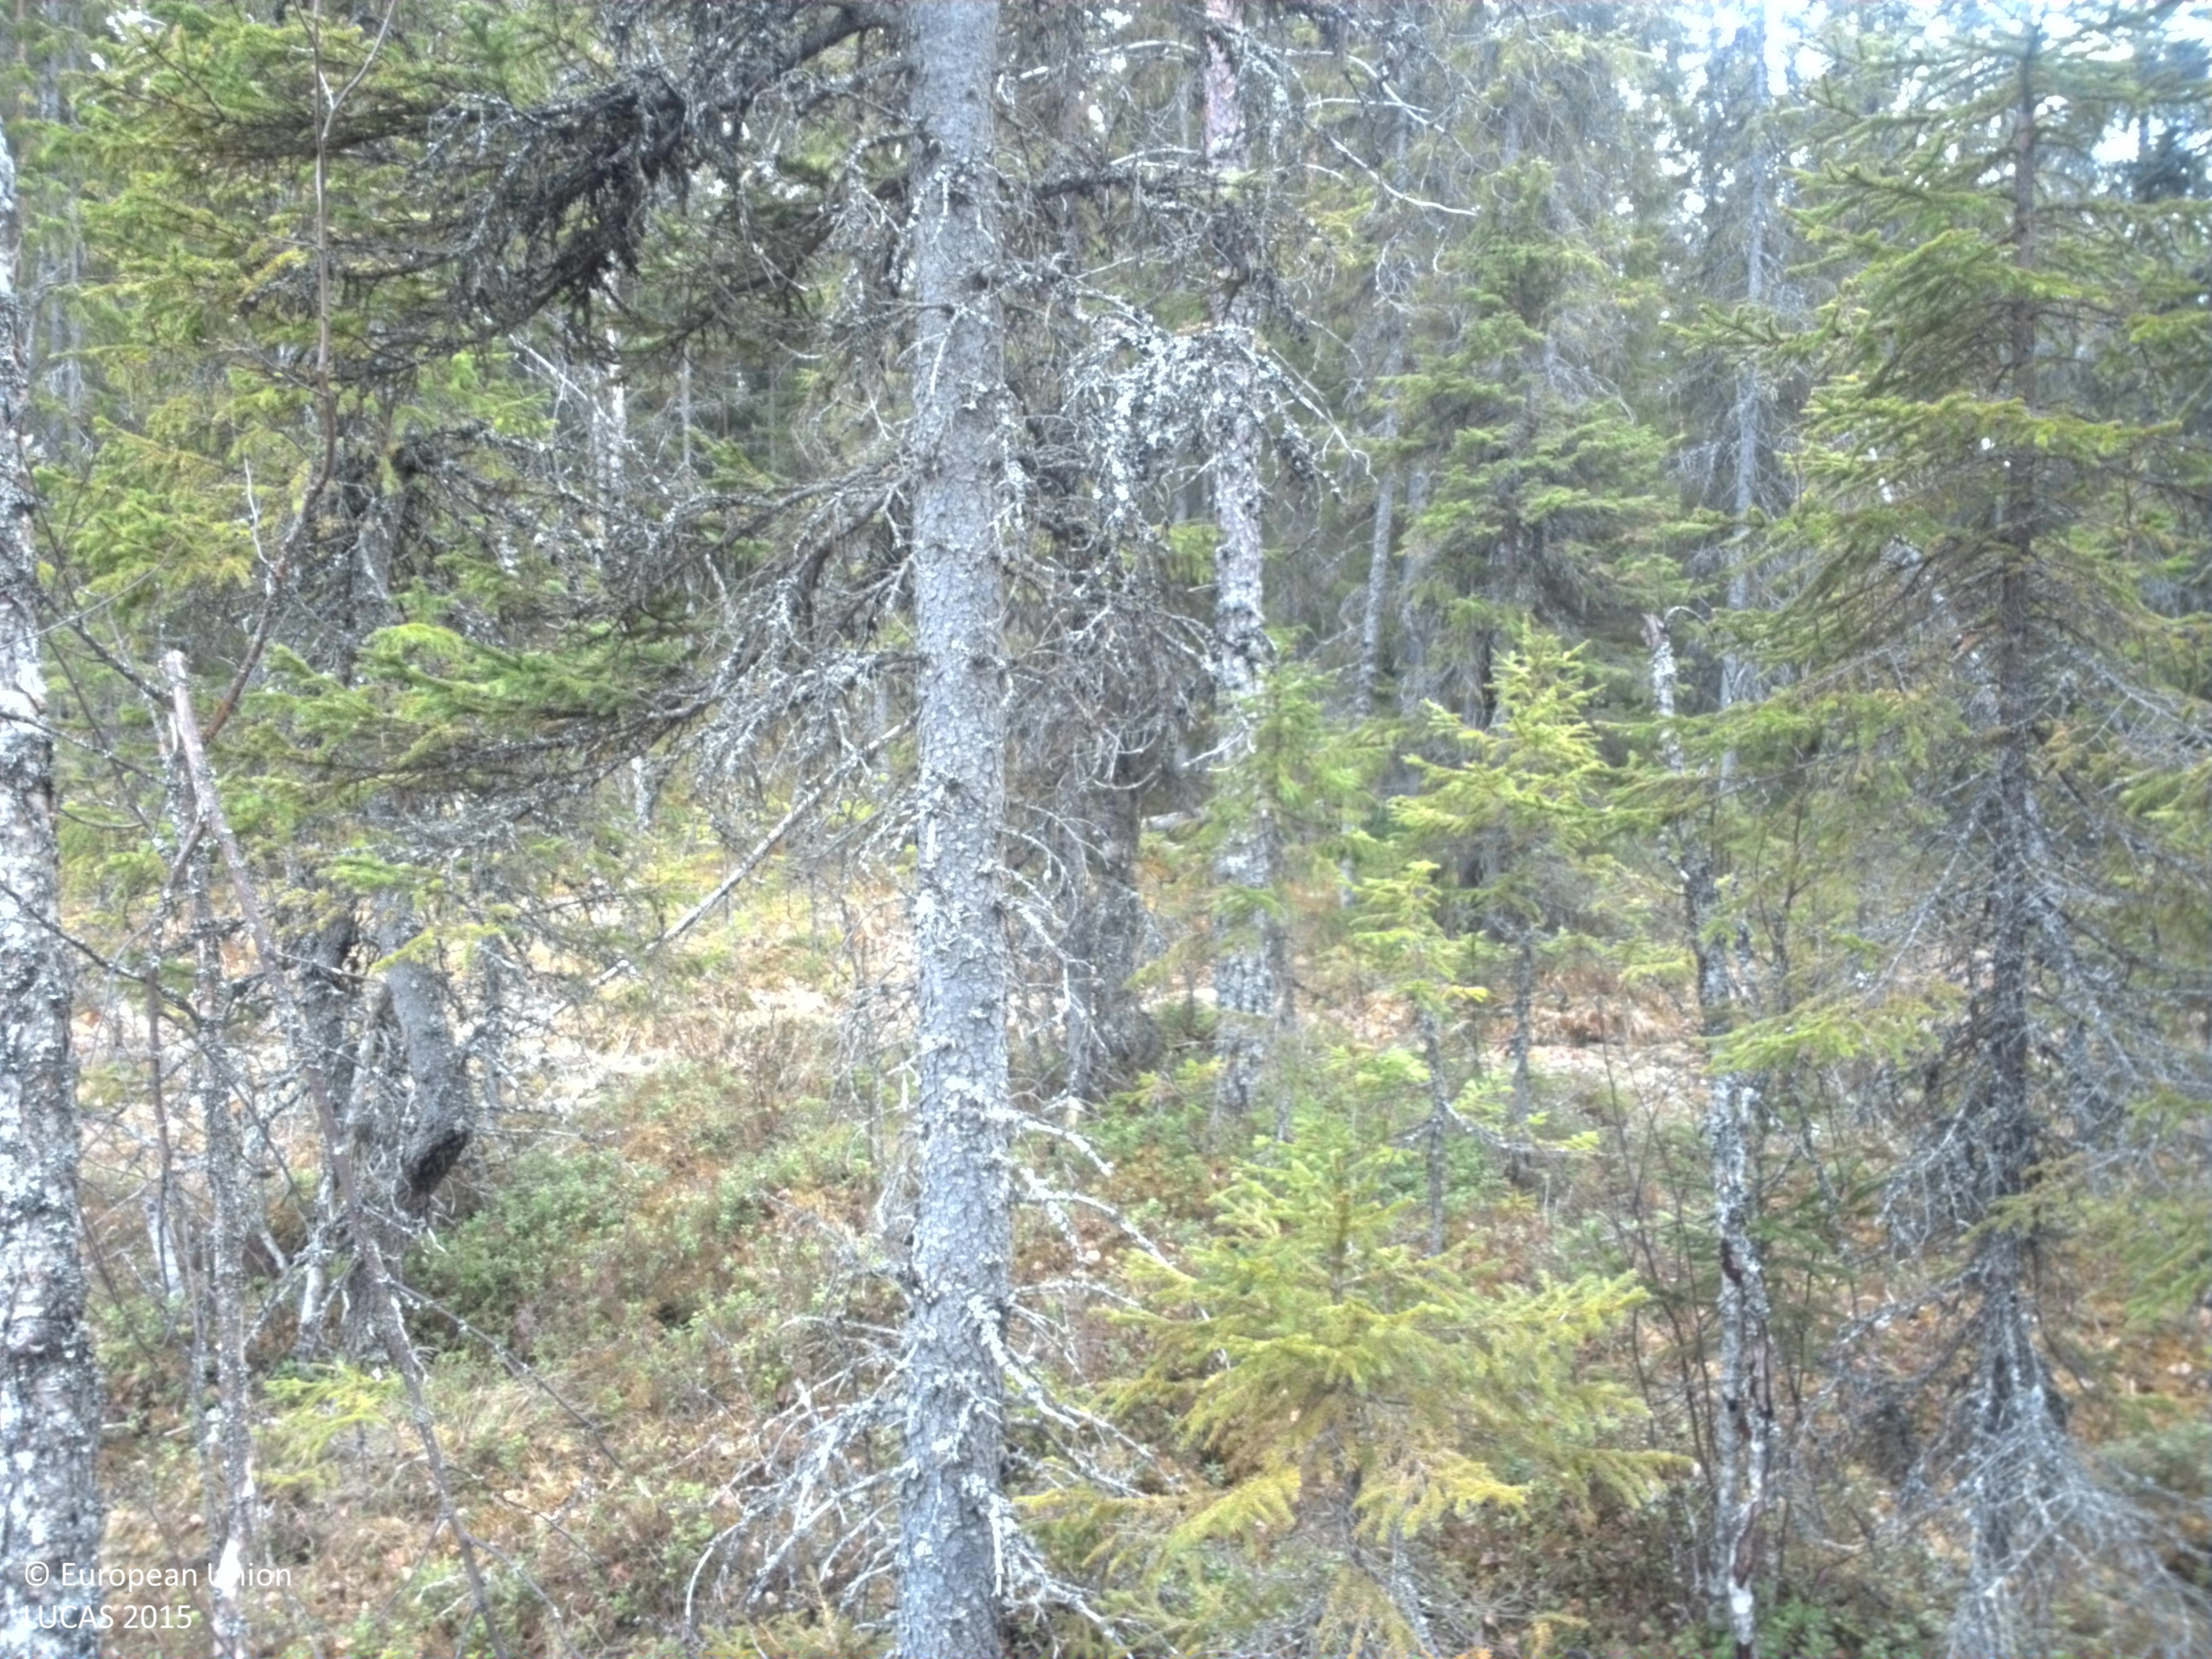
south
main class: Woodland
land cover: Other coniferous woodland
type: boreal forest
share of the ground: > 75 %
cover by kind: coniferous forest trees 75 %, shrubs 20 %, lichens and mosses 5 %
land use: Forestry
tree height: > 5 m
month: May
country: SE
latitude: 63.3596
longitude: 15.0343
